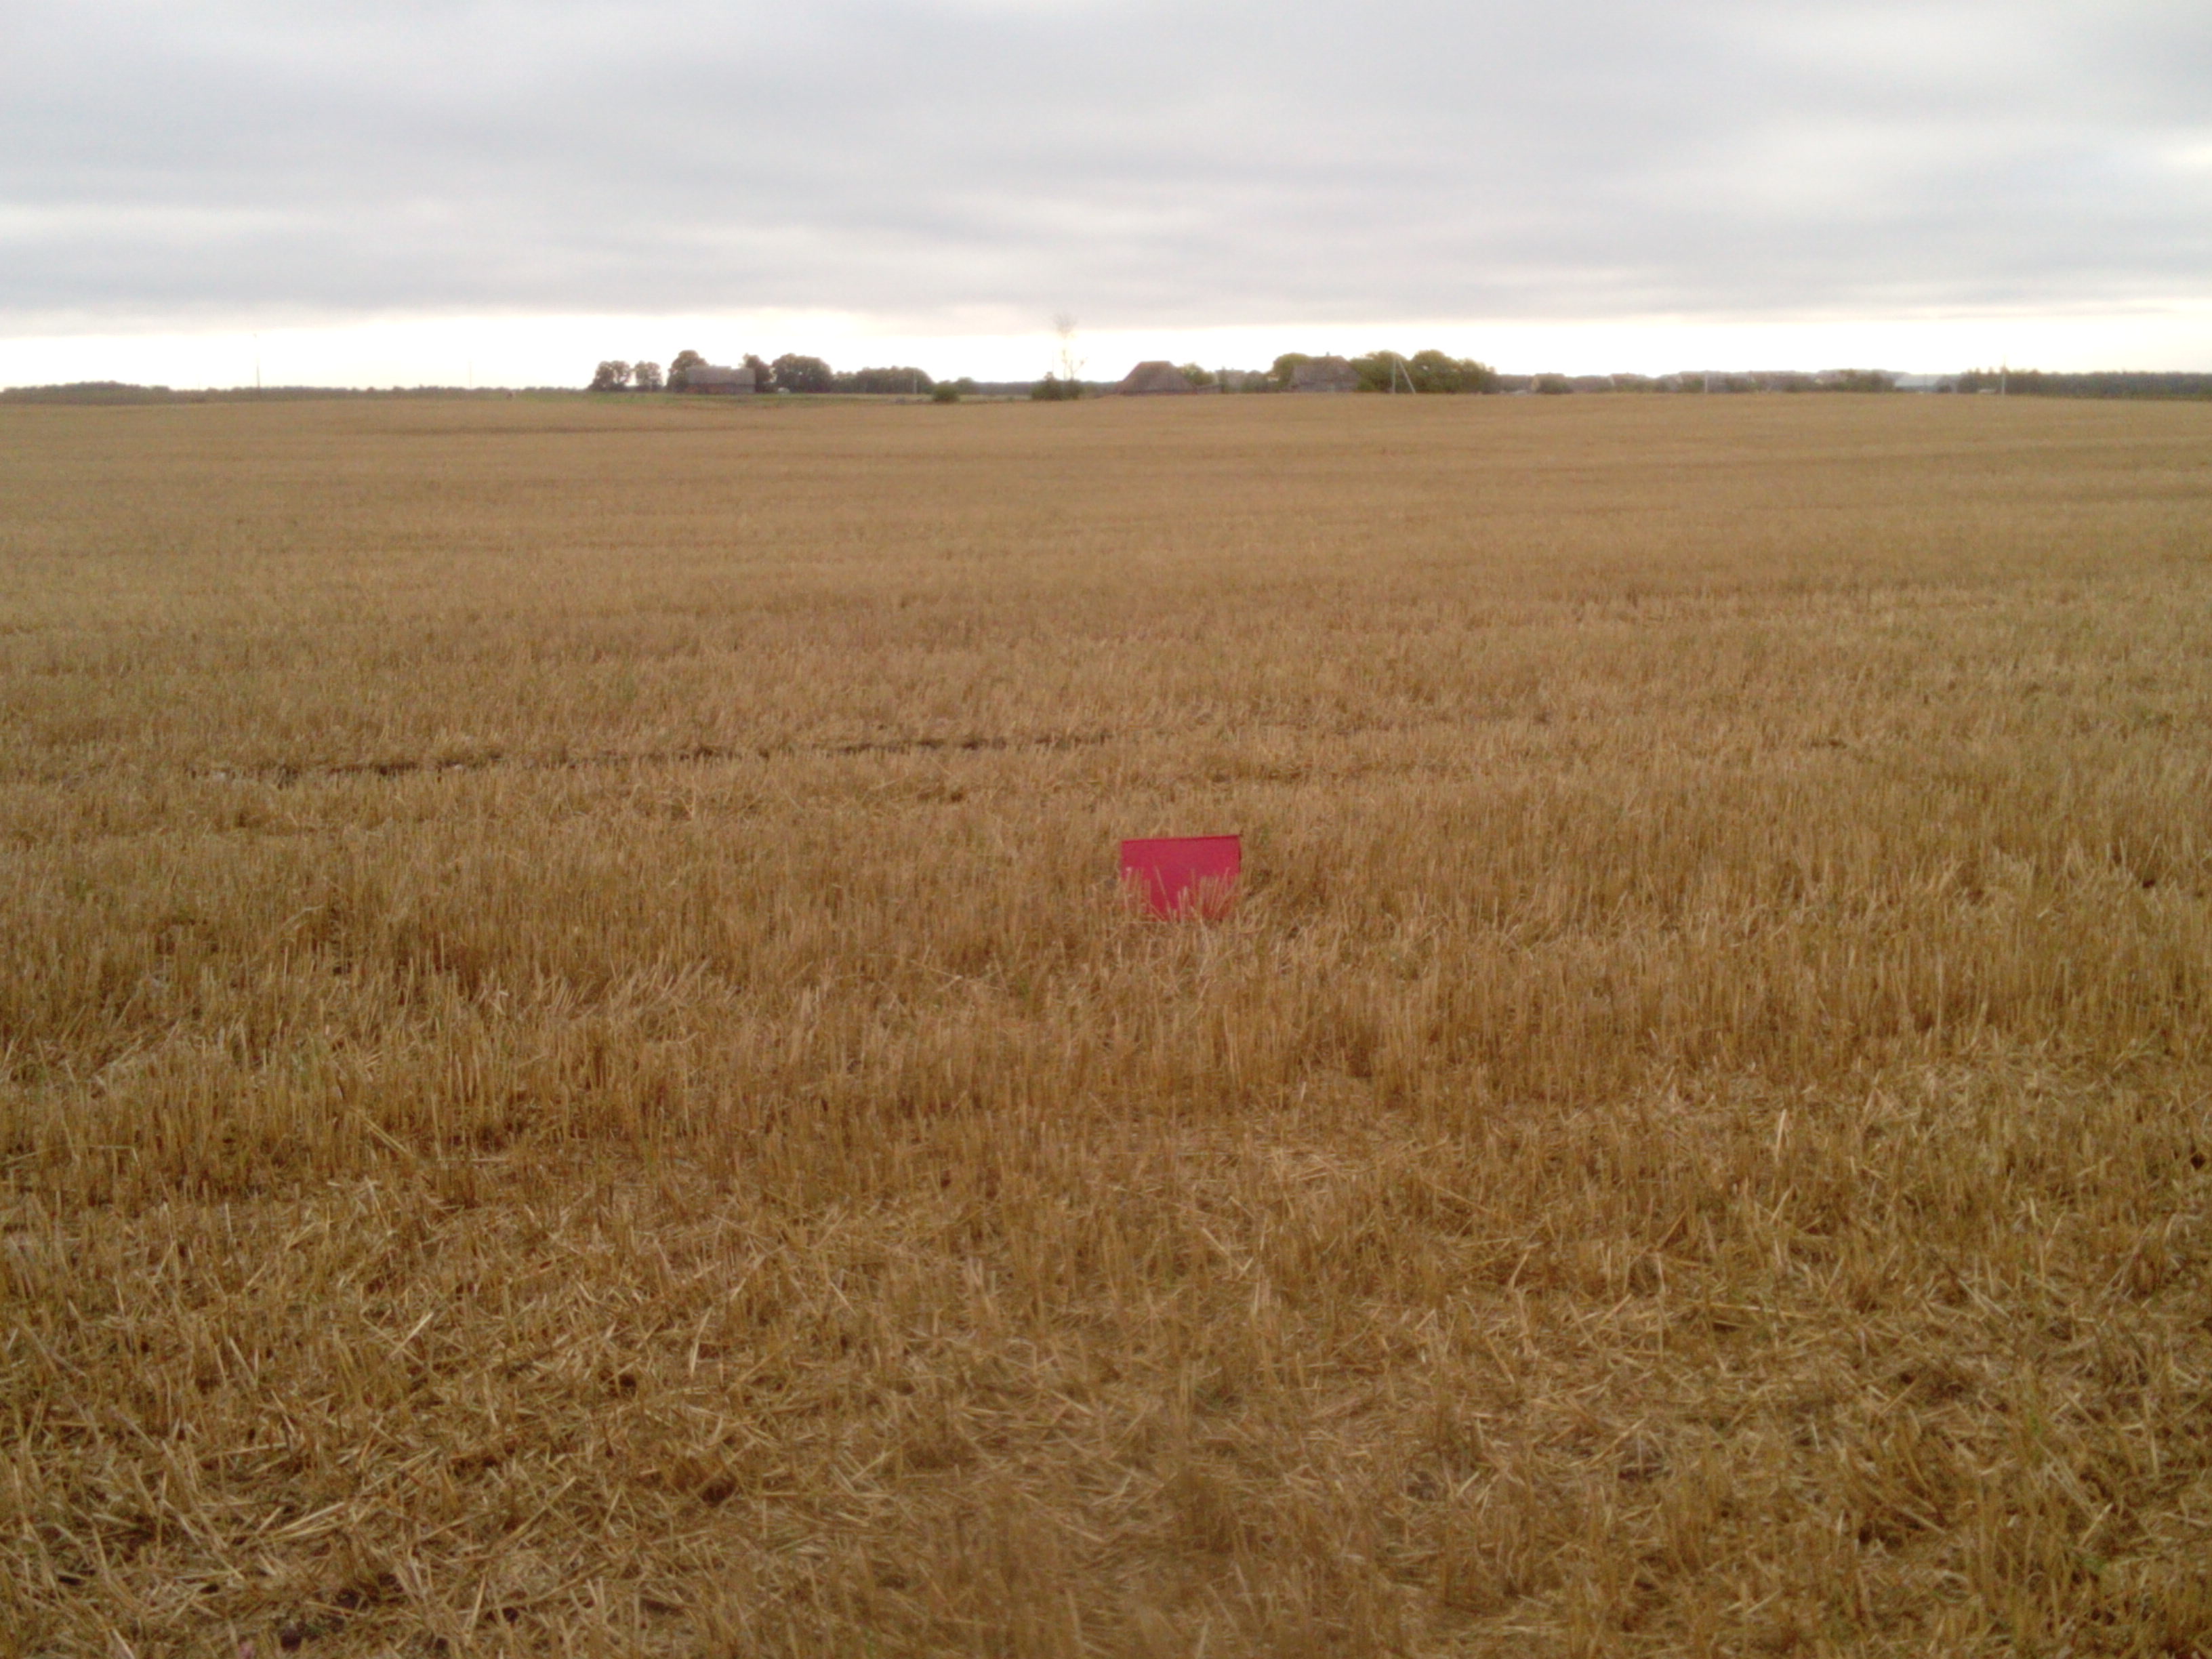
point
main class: Cropland
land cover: Barley
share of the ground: > 75 %
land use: Agriculture (excluding fallow land and kitchen gardens)
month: September
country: LT
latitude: 55.9354
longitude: 22.8885
